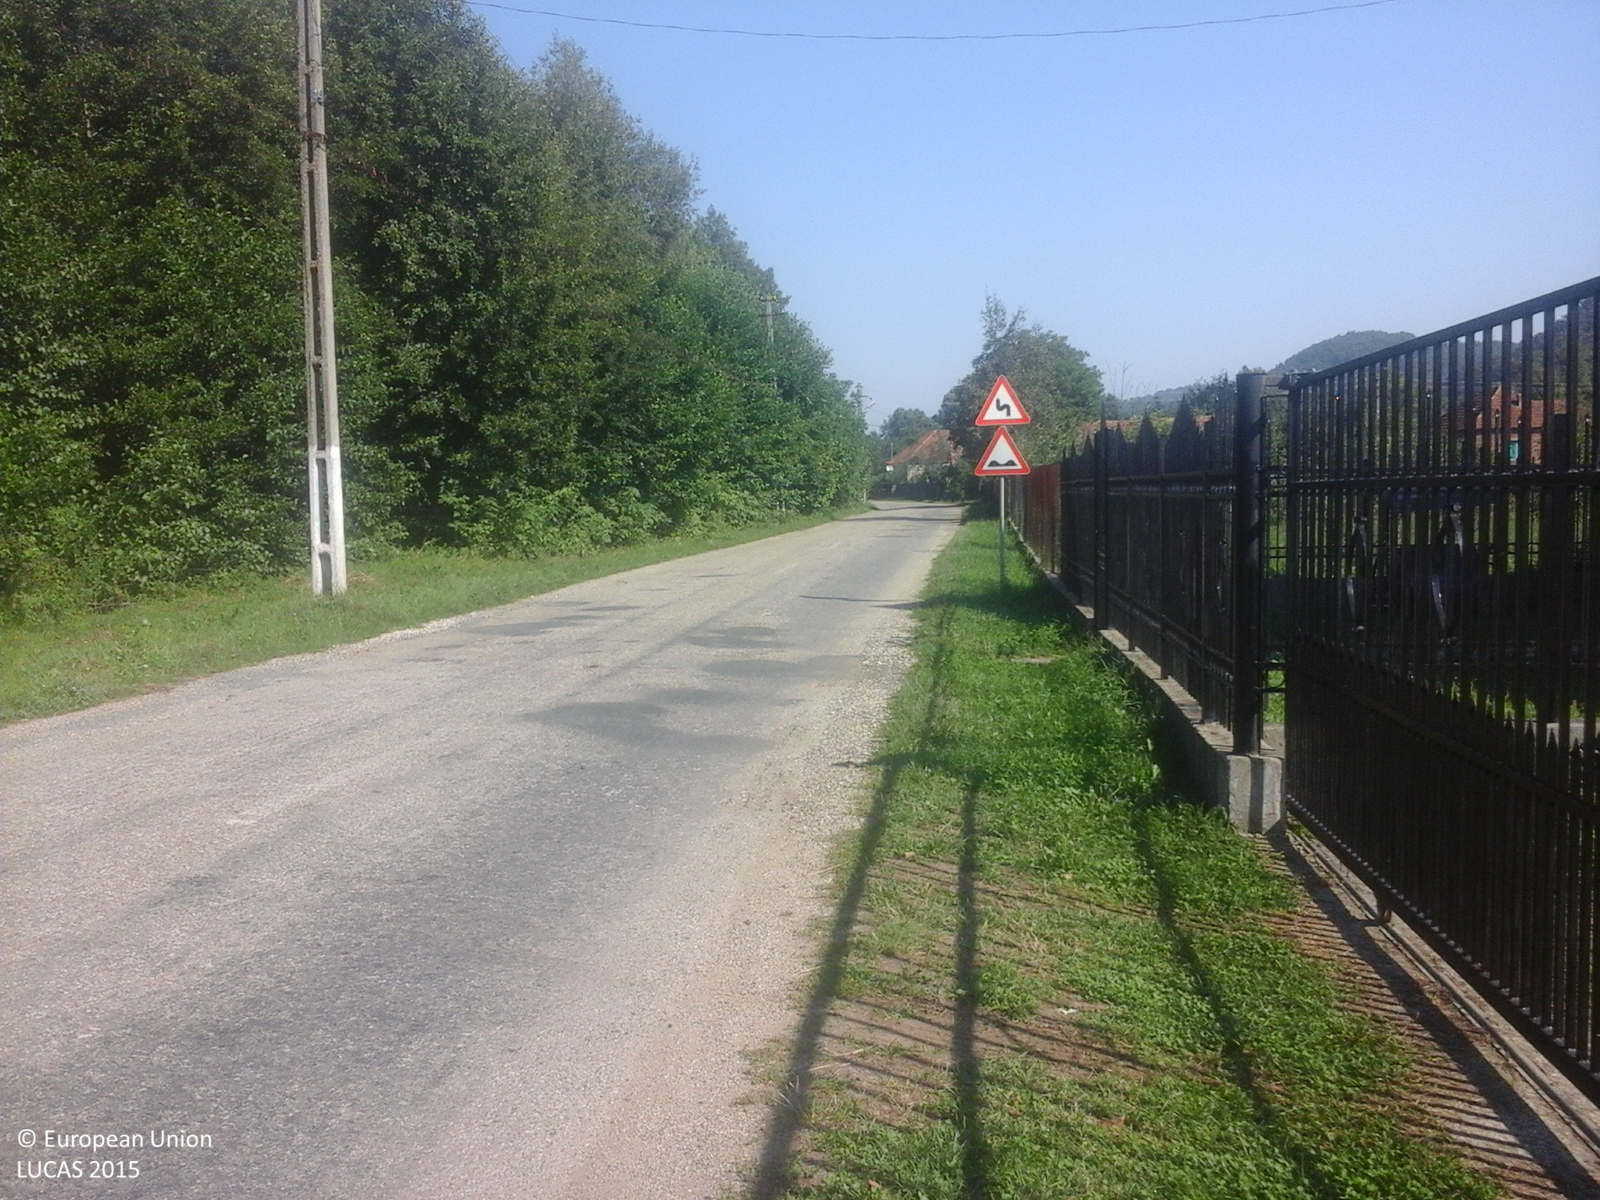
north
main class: Grassland
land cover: Grassland without tree/shrub cover
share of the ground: > 75 %
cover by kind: herbaceous plants 100 %
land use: Agriculture (excluding fallow land and kitchen gardens)
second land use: Residential
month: August
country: RO
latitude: 46.0467
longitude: 22.3889
